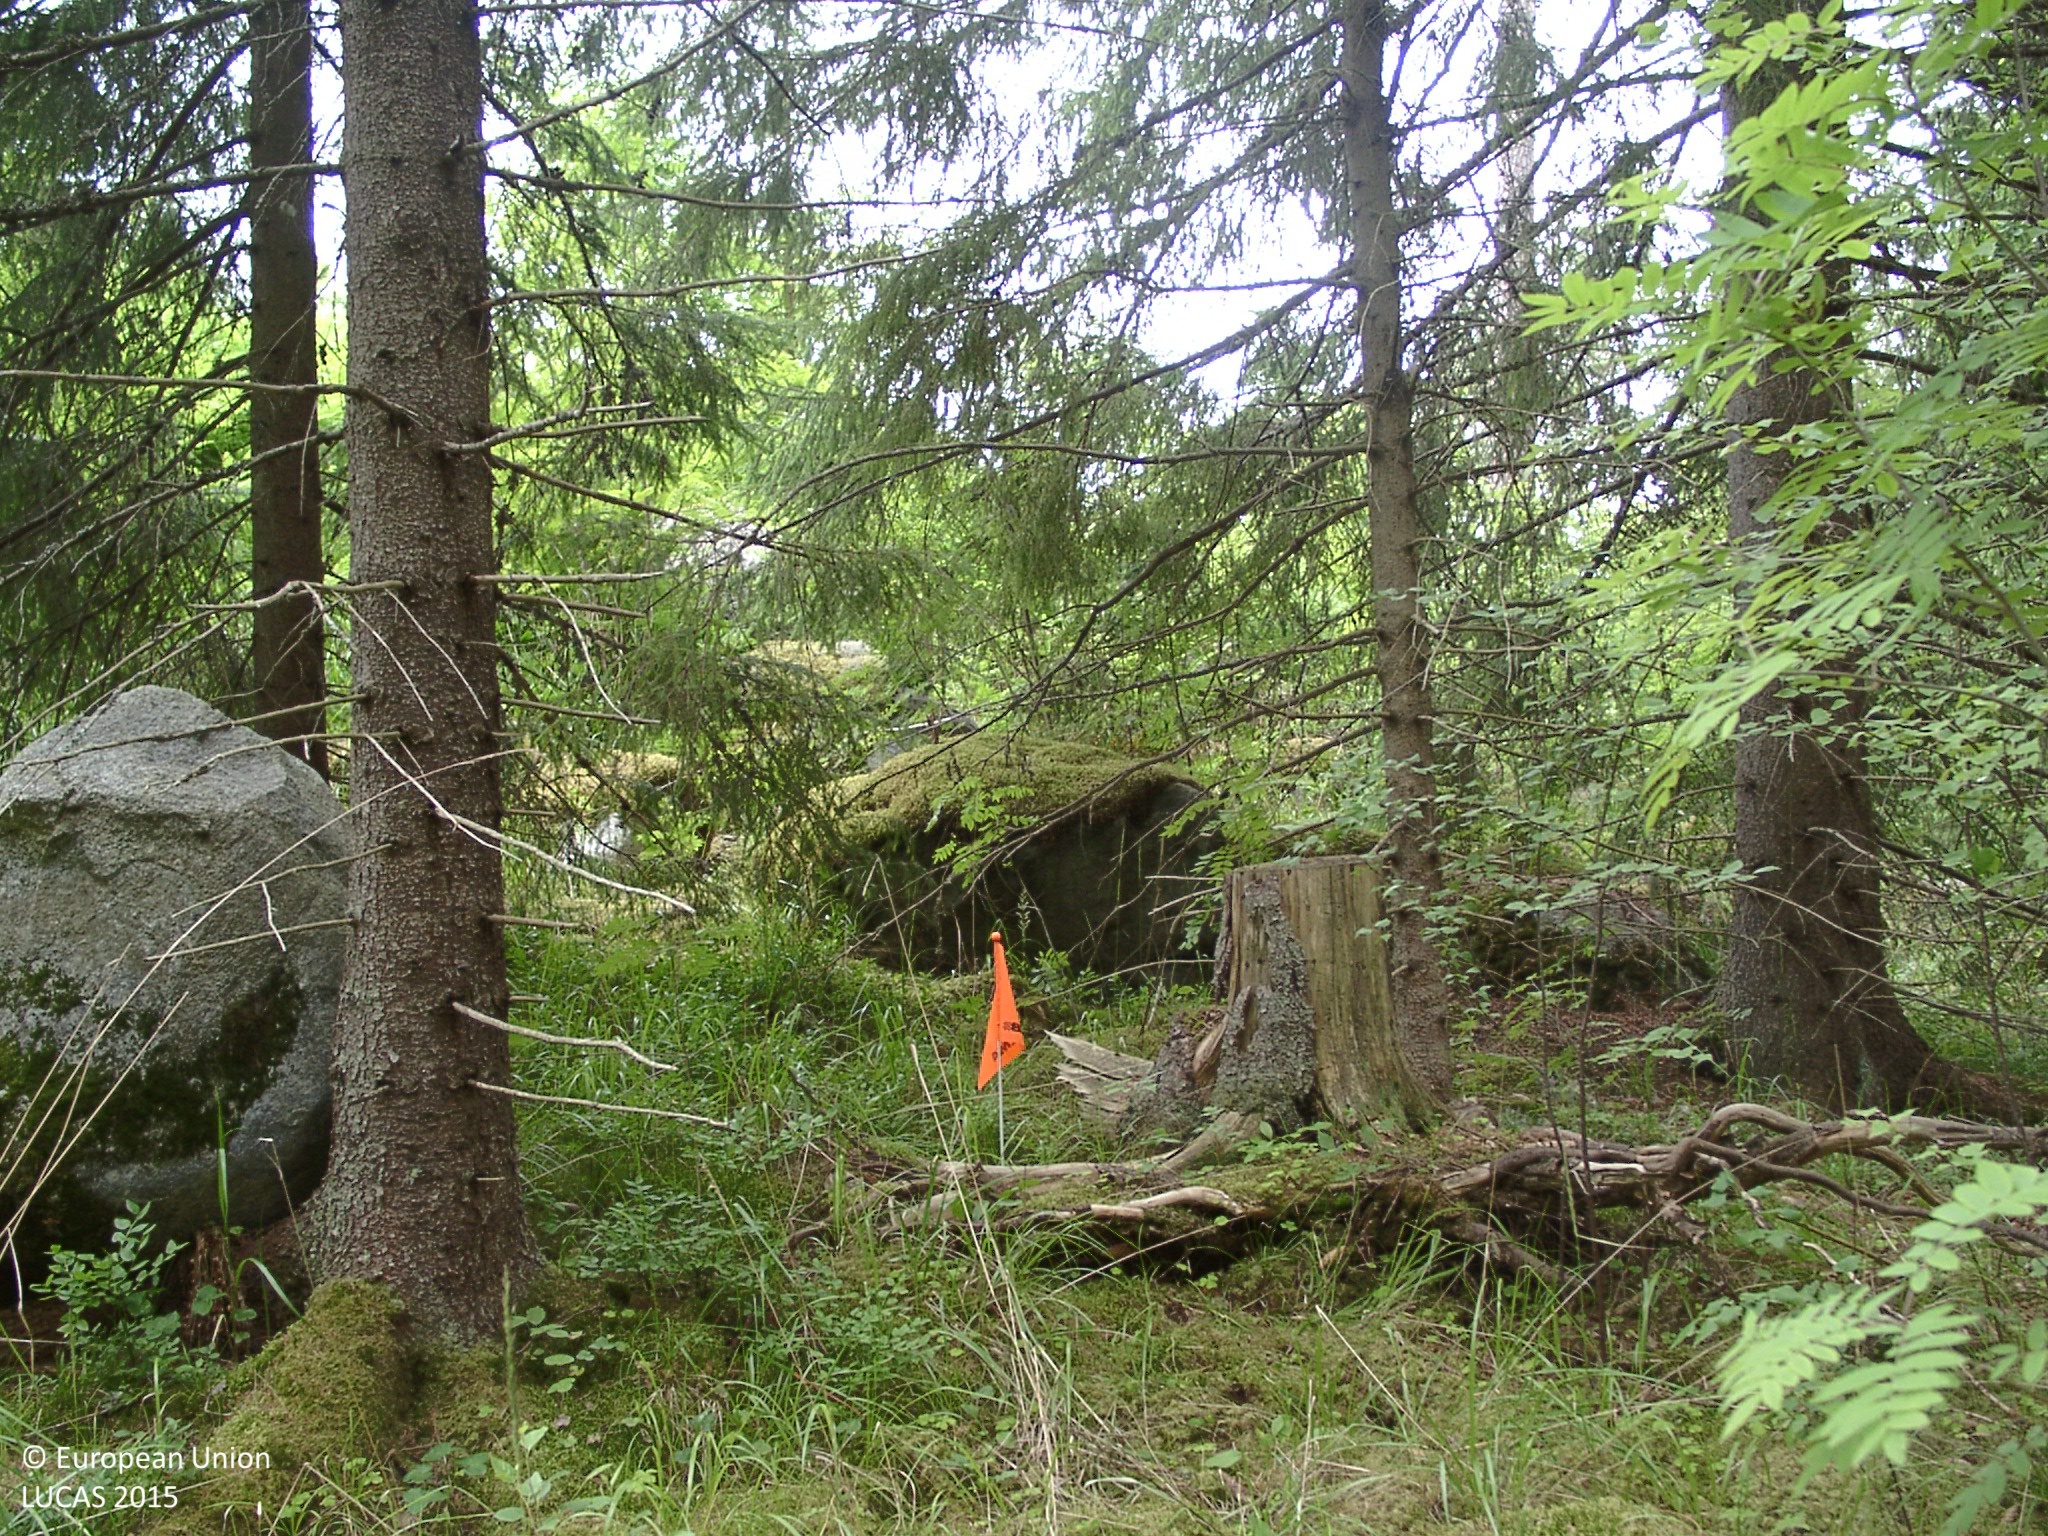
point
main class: Woodland
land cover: Spruce dominated coniferous woodland
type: boreal forest
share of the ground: > 75 %
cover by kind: coniferous forest trees 75 %, lichens and mosses 10 %, broadleaved forest trees 5 %, shrubs 5 %, herbaceous plants 5 %
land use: Forestry
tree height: > 5 m
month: July
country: FI
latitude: 61.5022
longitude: 25.2008
